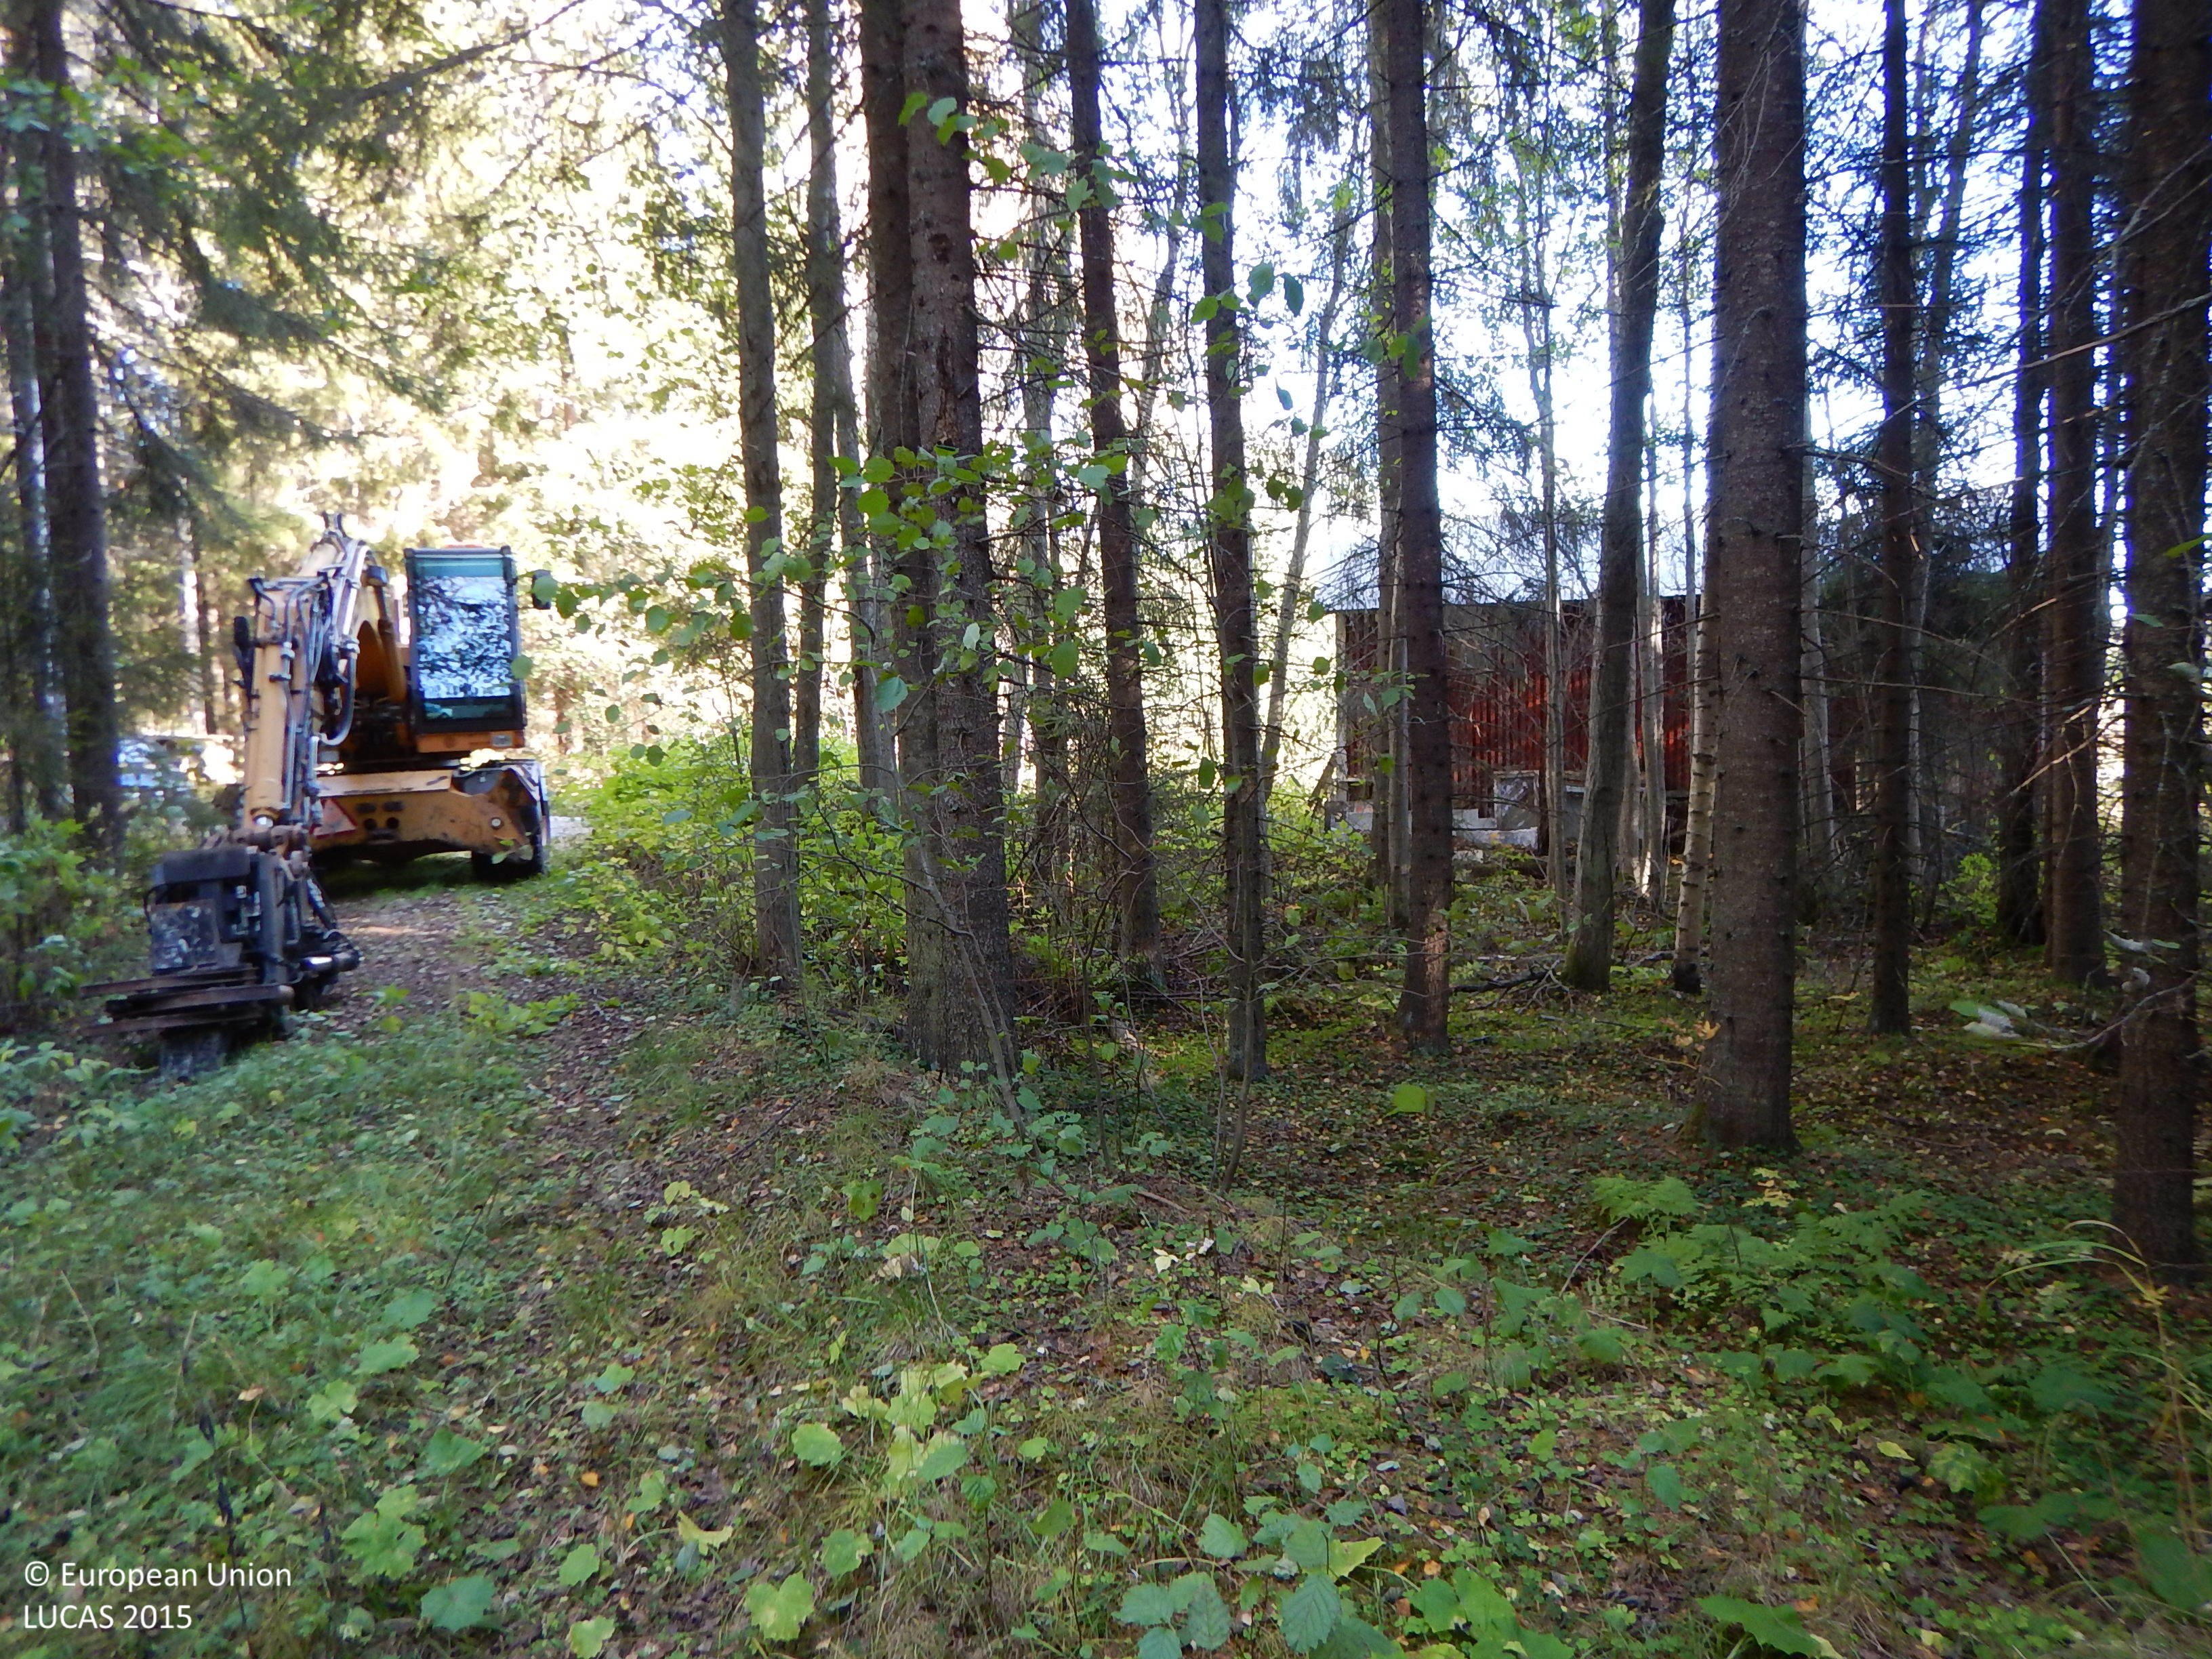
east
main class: Woodland
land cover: Spruce dominated mixed woodland
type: boreal forest
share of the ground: 50 - 75 %
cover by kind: coniferous forest trees 50 %, broadleaved forest trees 20 %, shrubs 15 %, herbaceous plants 10 %, lichens and mosses 5 %
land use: Forestry
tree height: > 5 m
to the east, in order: Tracks; Spruce dominated coniferous woodland; Paved roads, cycling and walking lanes; Broadleaved woodland; Electric lines; Ditches and canals; Grass margins; Paved roads, cycling and walking lanes; Ditches and canals; Grass margins; Ditches and canals; Grassland without tree/shrub cover; Grassland with sparse tree/shrub cover; Other bare soil
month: October
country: SE
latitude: 64.8867
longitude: 20.8086
